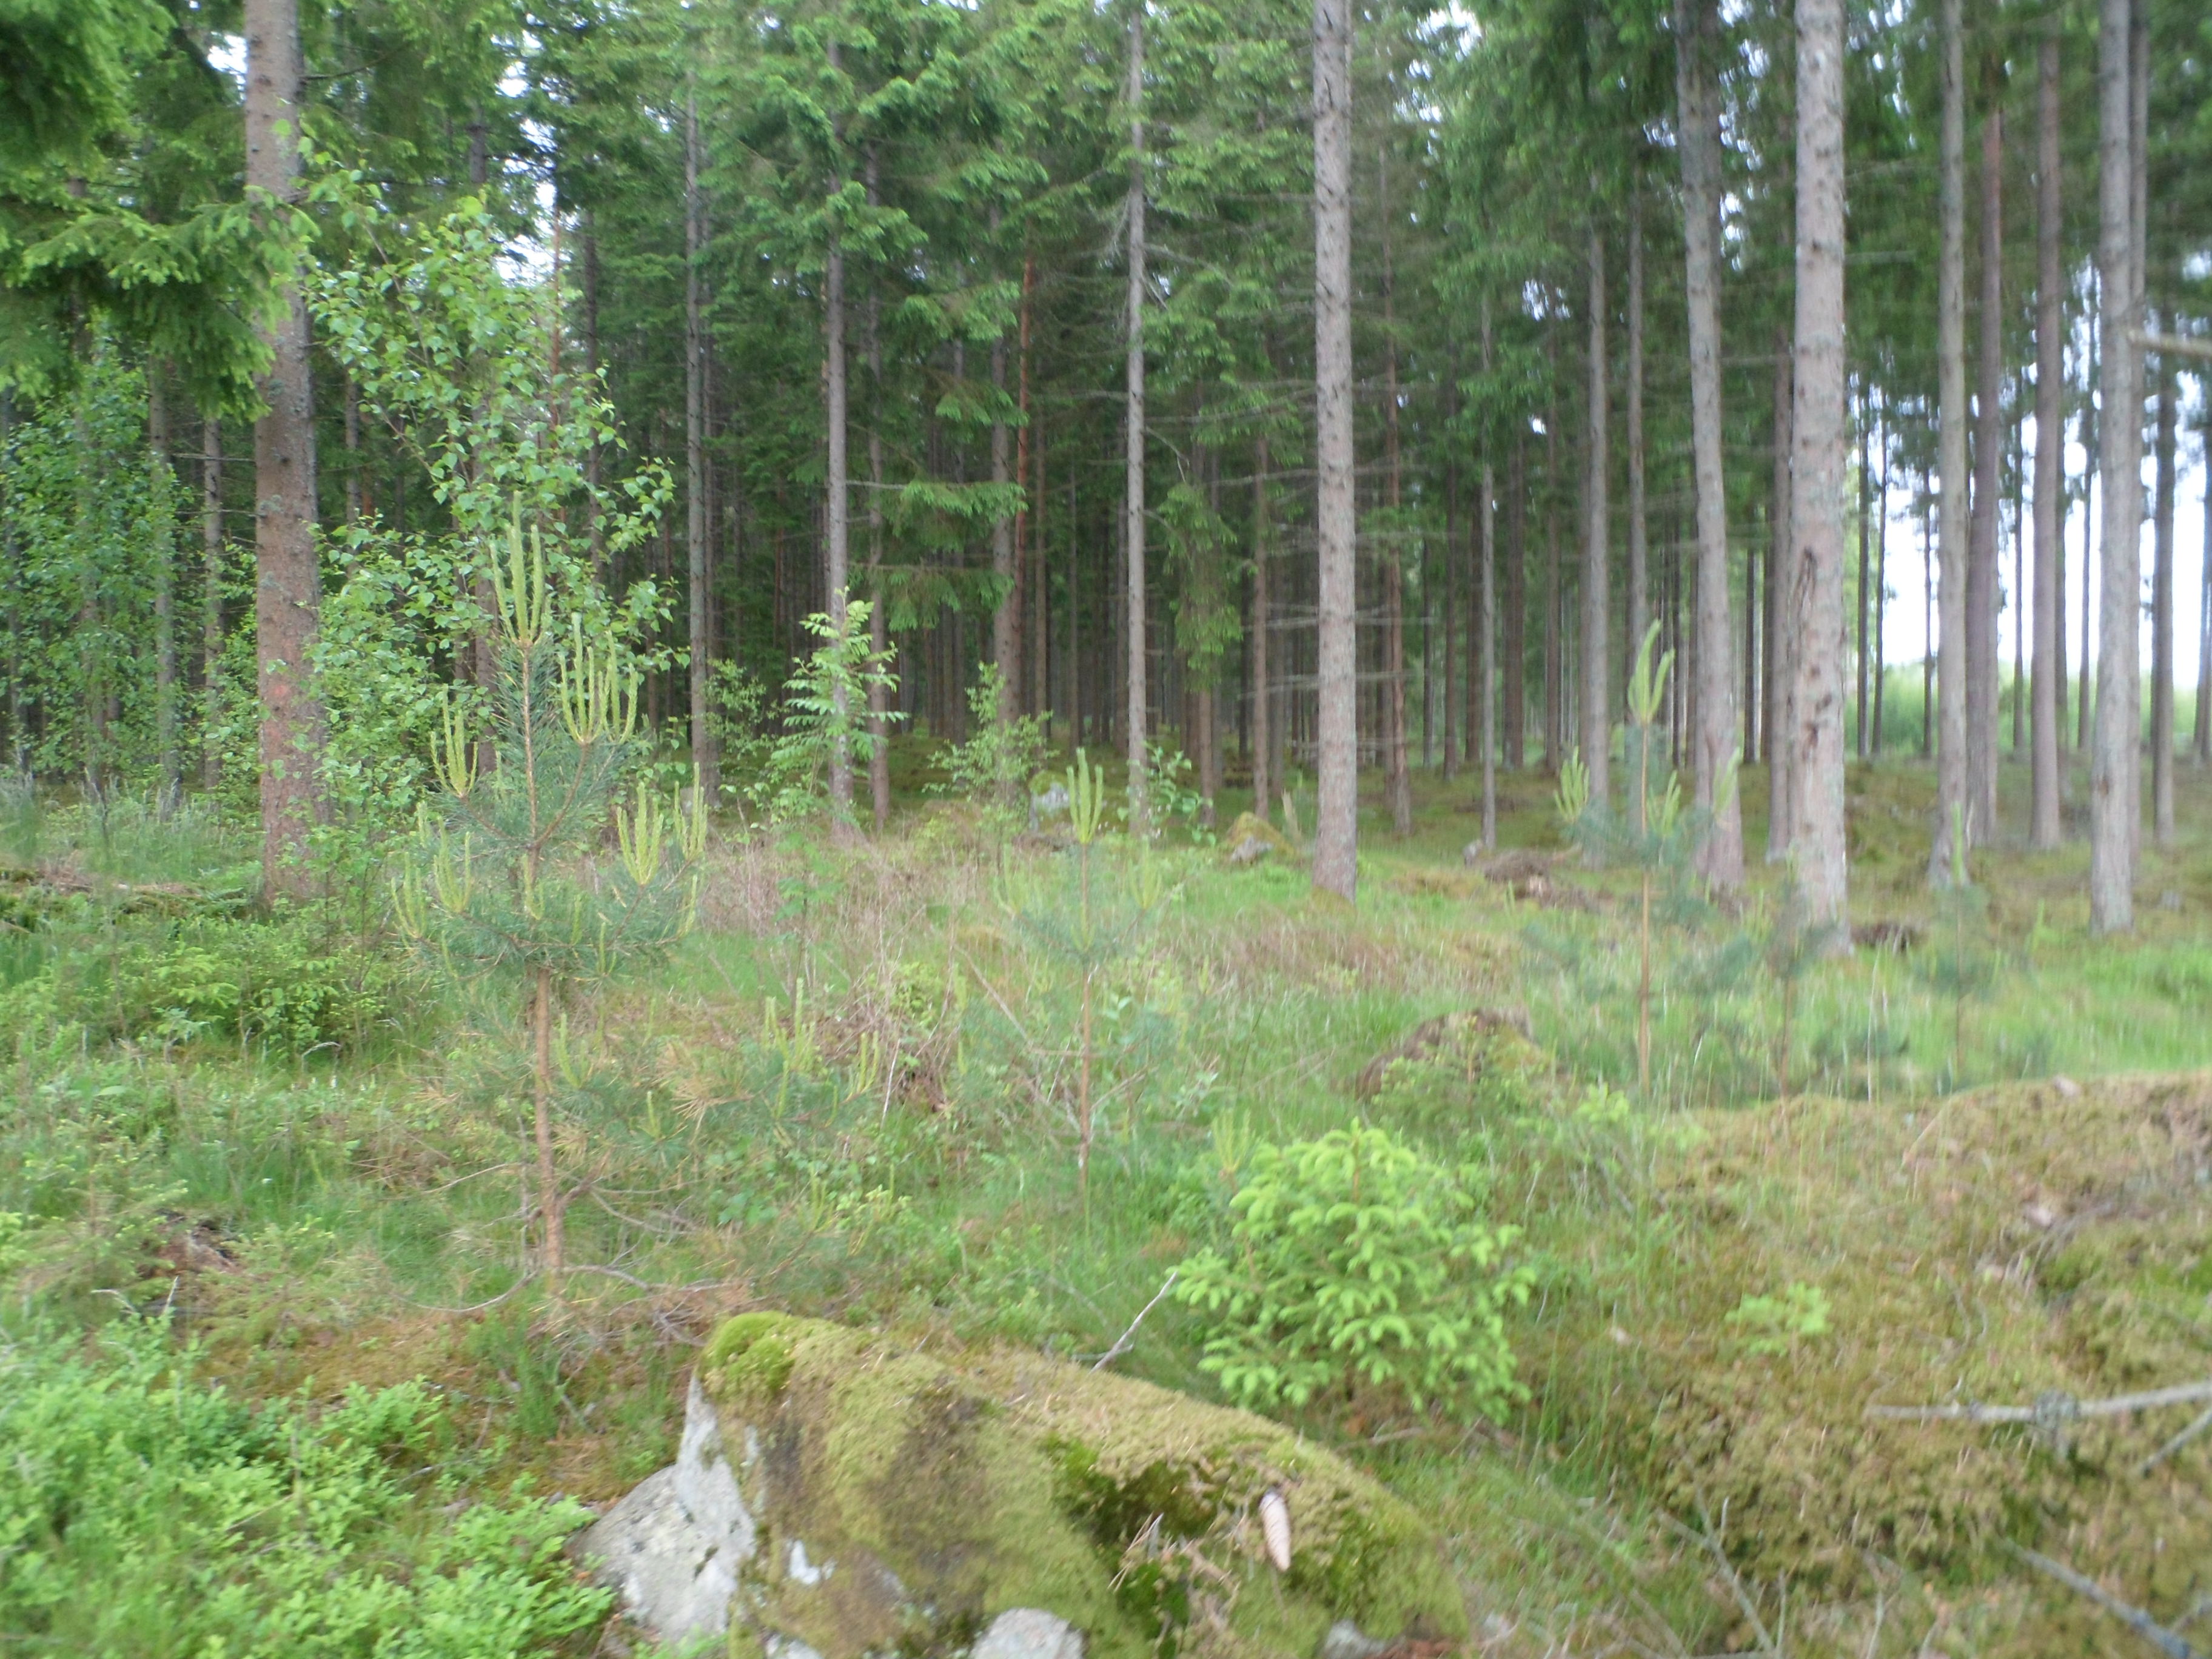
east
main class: Woodland
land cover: Spruce dominated coniferous woodland
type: boreal forest
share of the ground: 50 - 75 %
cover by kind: coniferous forest trees 55 %, shrubs 25 %, lichens and mosses 10 %, broadleaved forest trees 5 %, herbaceous plants 5 %
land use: Forestry
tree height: > 5 m
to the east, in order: Spruce dominated coniferous woodland; Tracks; Spruce dominated coniferous woodland; Tracks; Spruce dominated coniferous woodland; Pine dominated coniferous woodland; Pine dominated mixed woodland; Pine dominated coniferous woodland
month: June
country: SE
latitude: 56.8795
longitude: 14.6080
